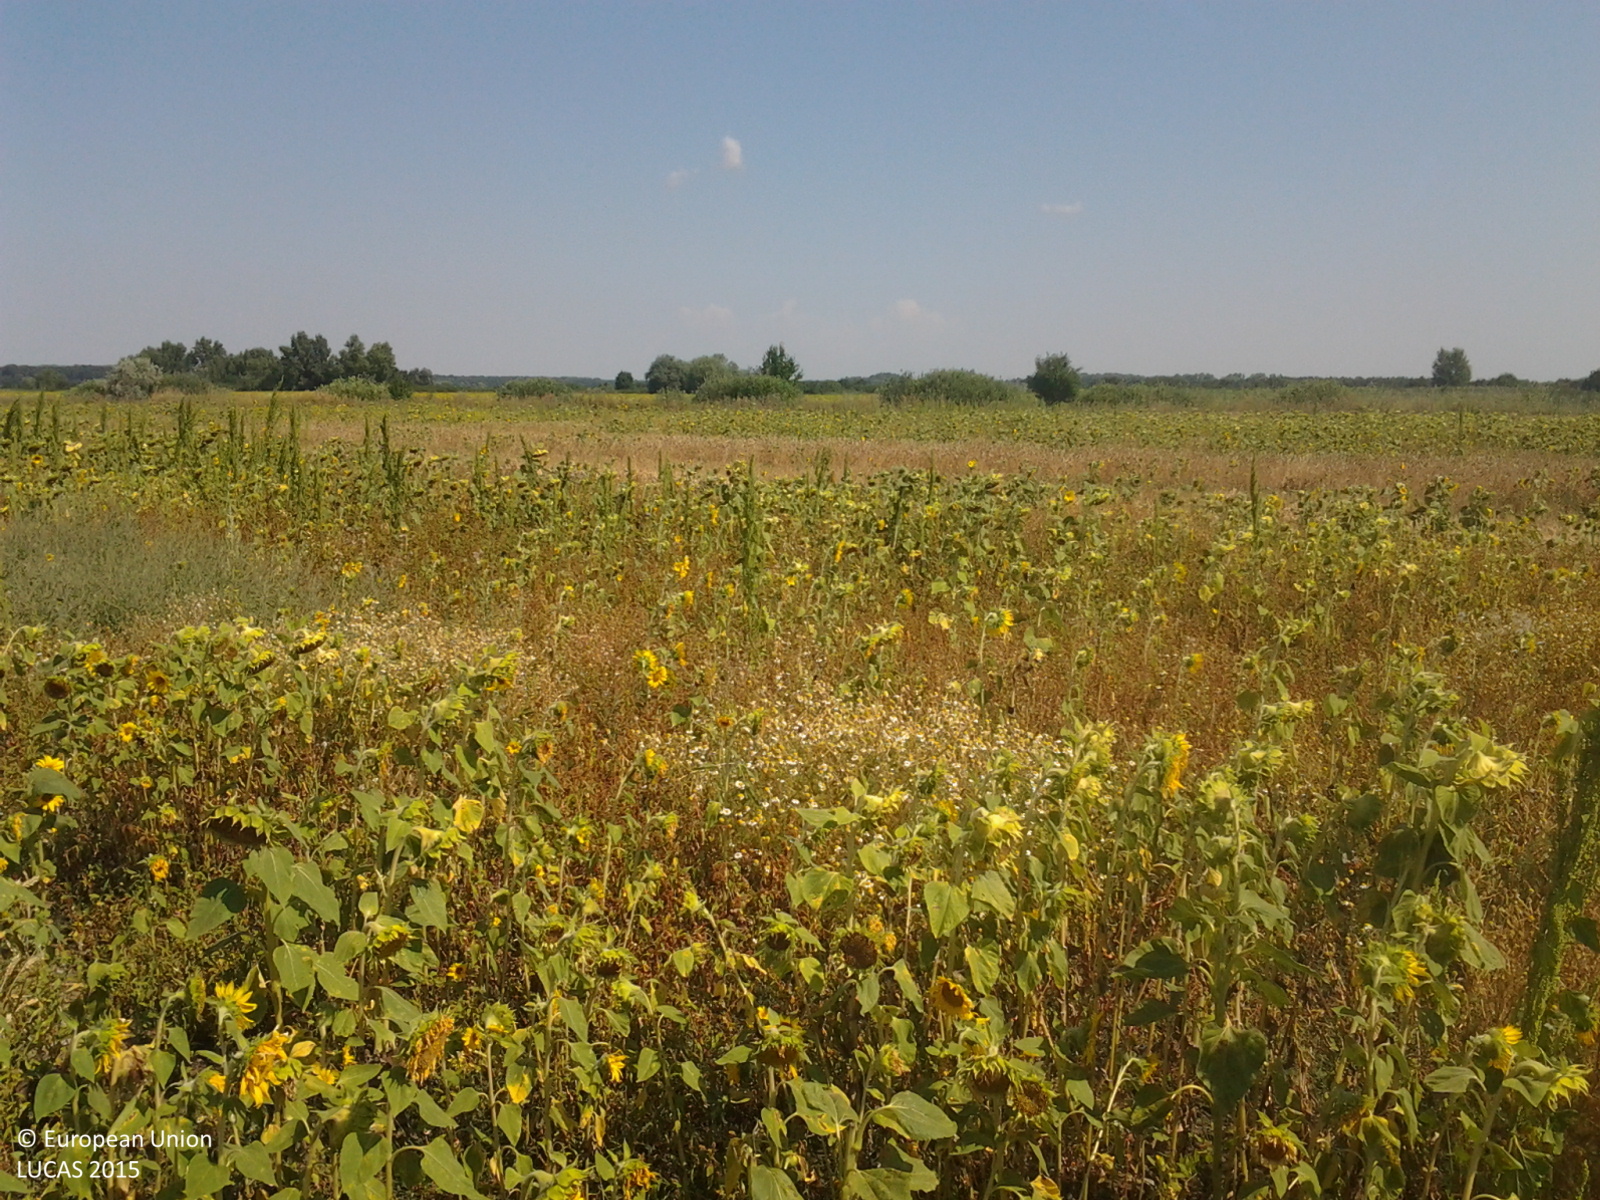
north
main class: Cropland
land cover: Common wheat
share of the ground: 50 - 75 %
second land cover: Sunflower
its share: 25 - 50 %
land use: Agriculture (excluding fallow land and kitchen gardens)
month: July
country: HU
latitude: 47.3320
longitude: 20.5780
